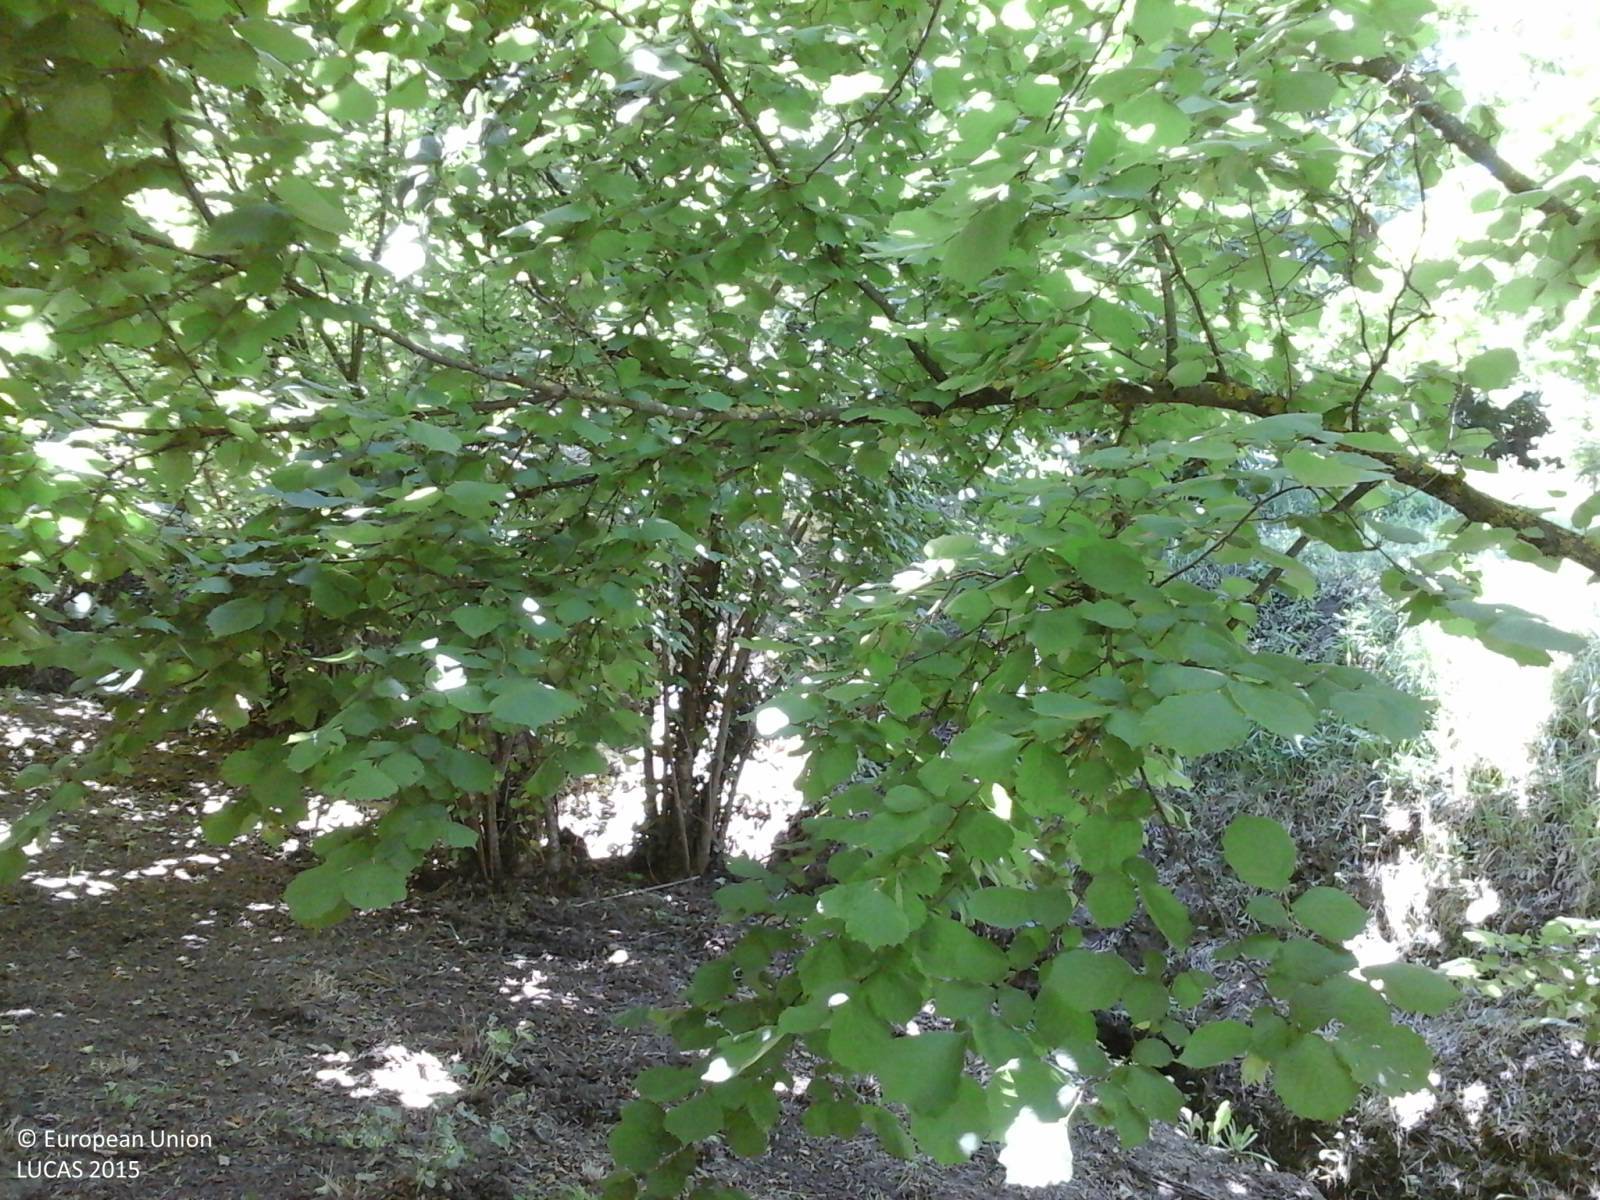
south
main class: Cropland
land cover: Nuts trees
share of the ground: > 75 %
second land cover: Other bare soil
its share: > 75 %
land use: Agriculture (excluding fallow land and kitchen gardens)
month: June
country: IT
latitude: 42.4852
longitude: 12.2189
